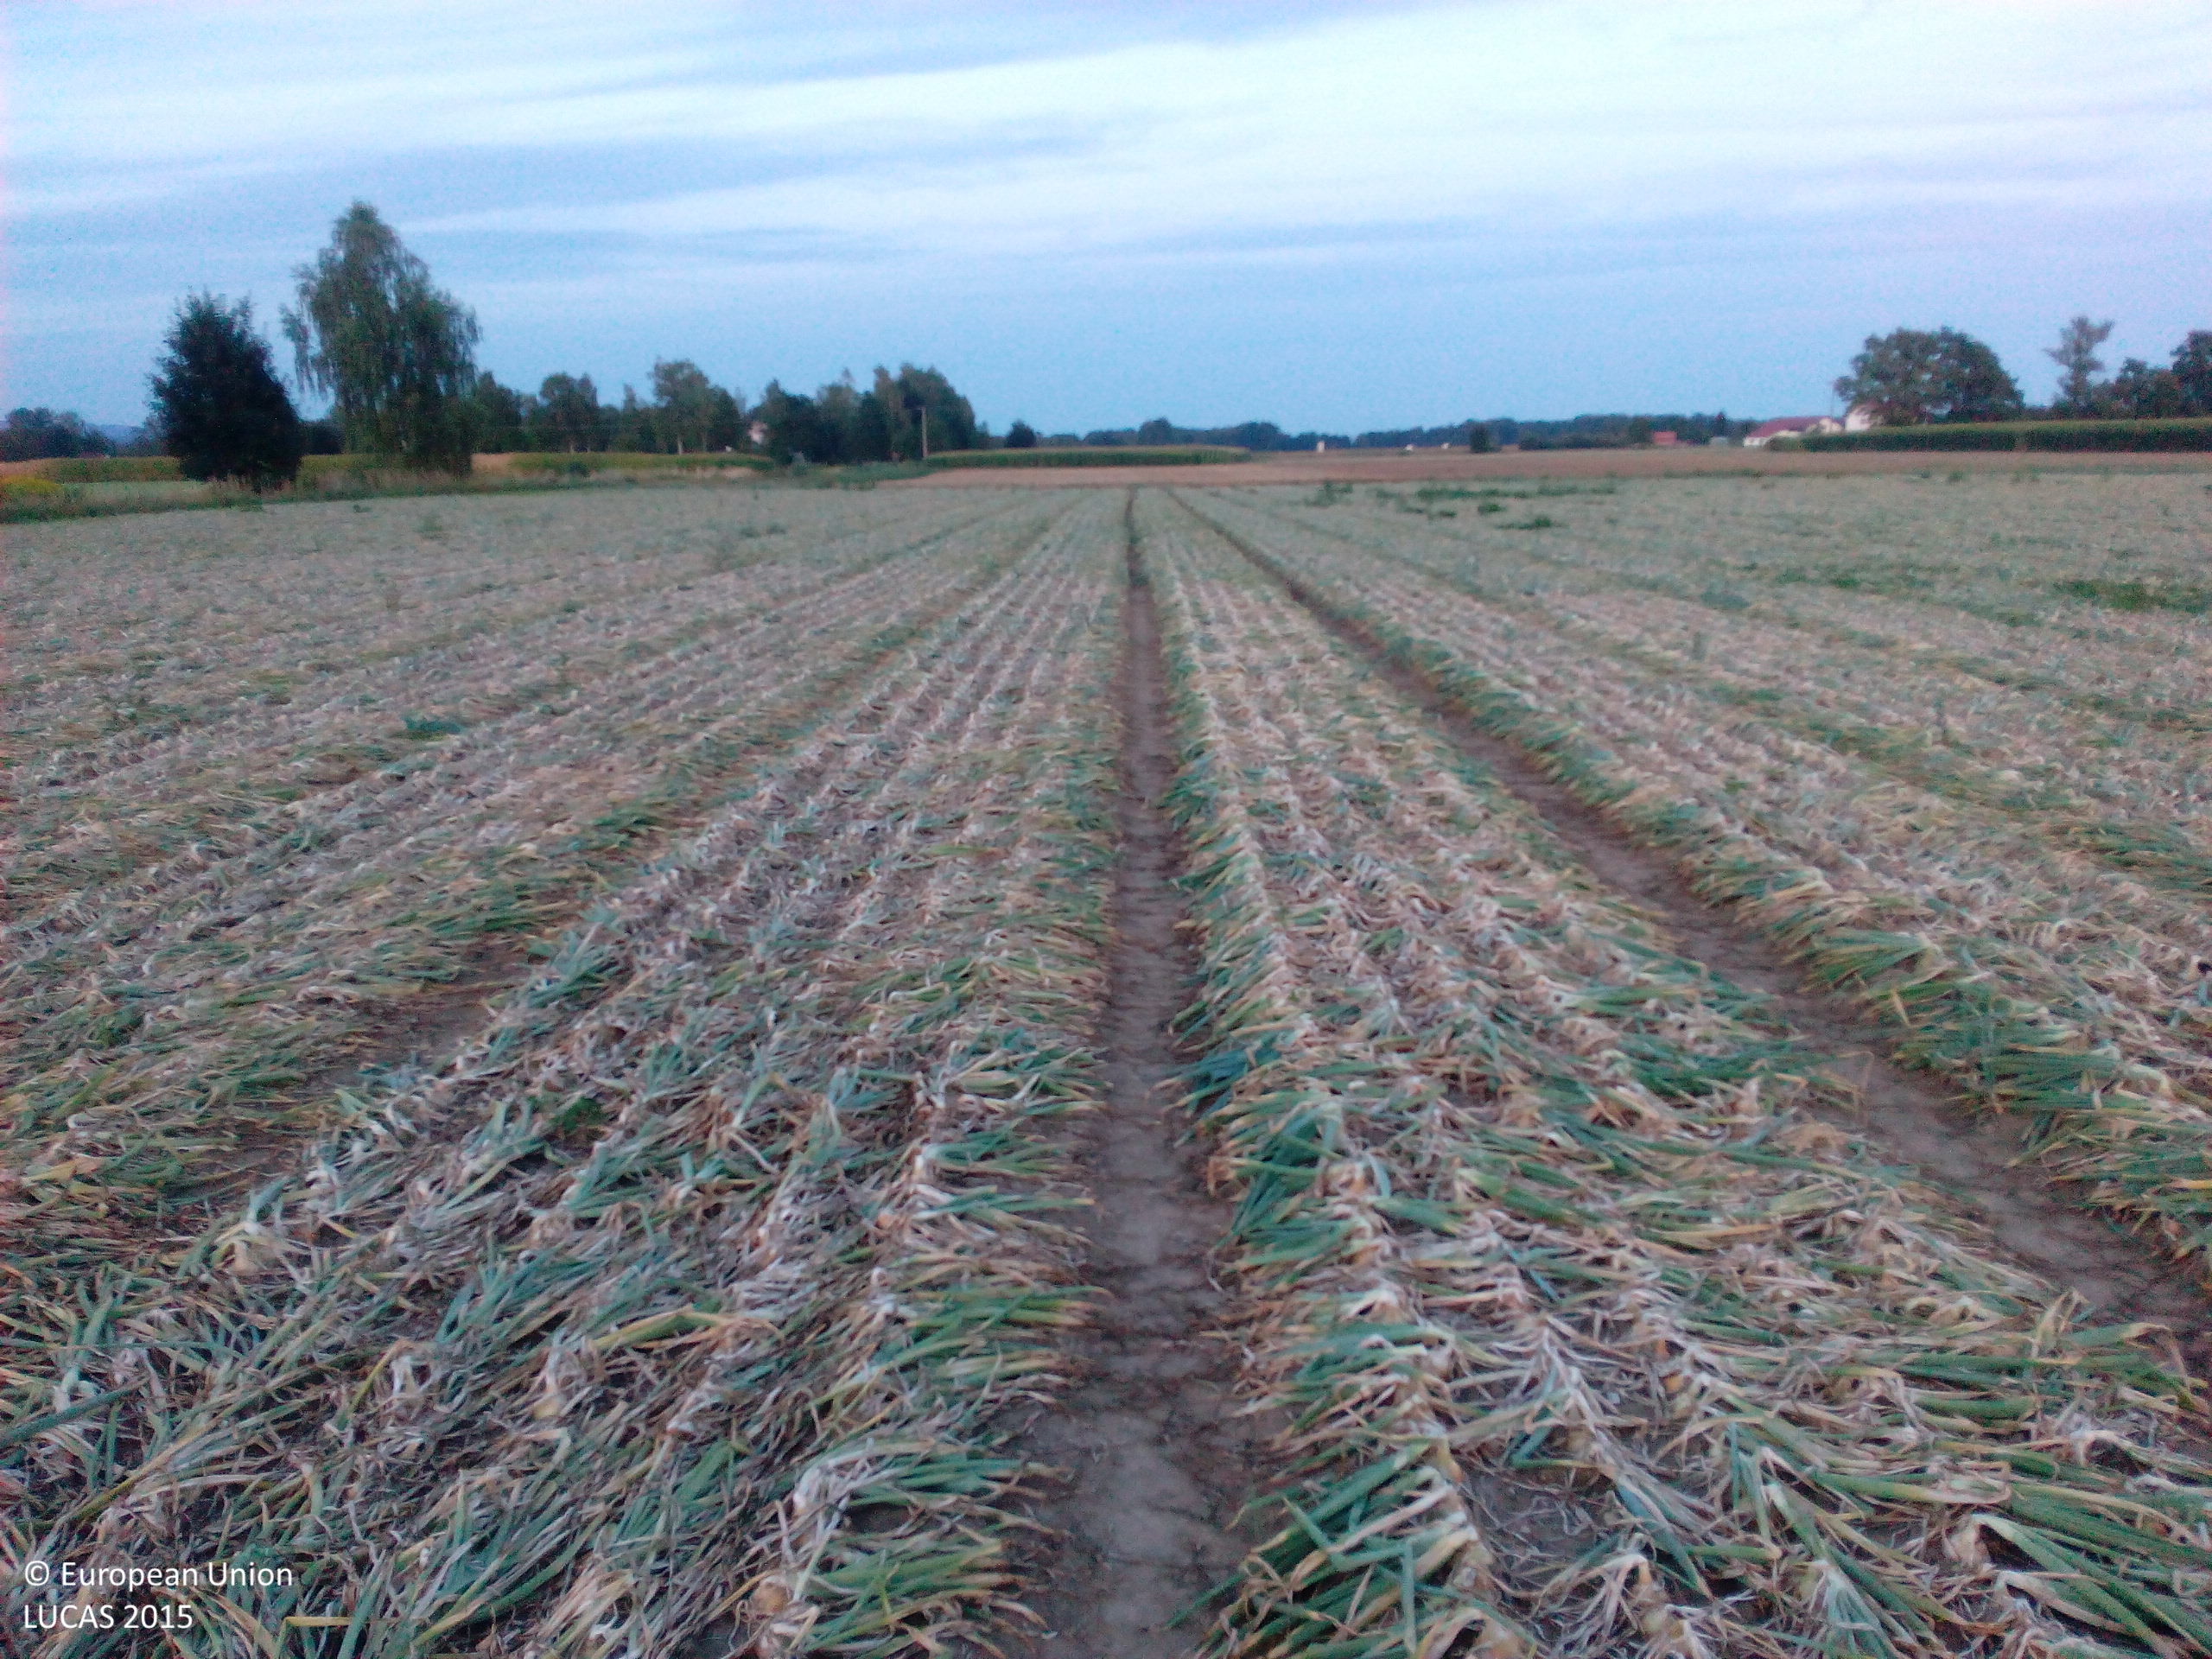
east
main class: Cropland
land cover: Other root crops
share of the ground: 50 - 75 %
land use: Agriculture (excluding fallow land and kitchen gardens)
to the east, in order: Other root crops; Oats; Tracks; Other bare soil
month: August
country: DE
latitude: 48.7609
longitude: 12.9242
